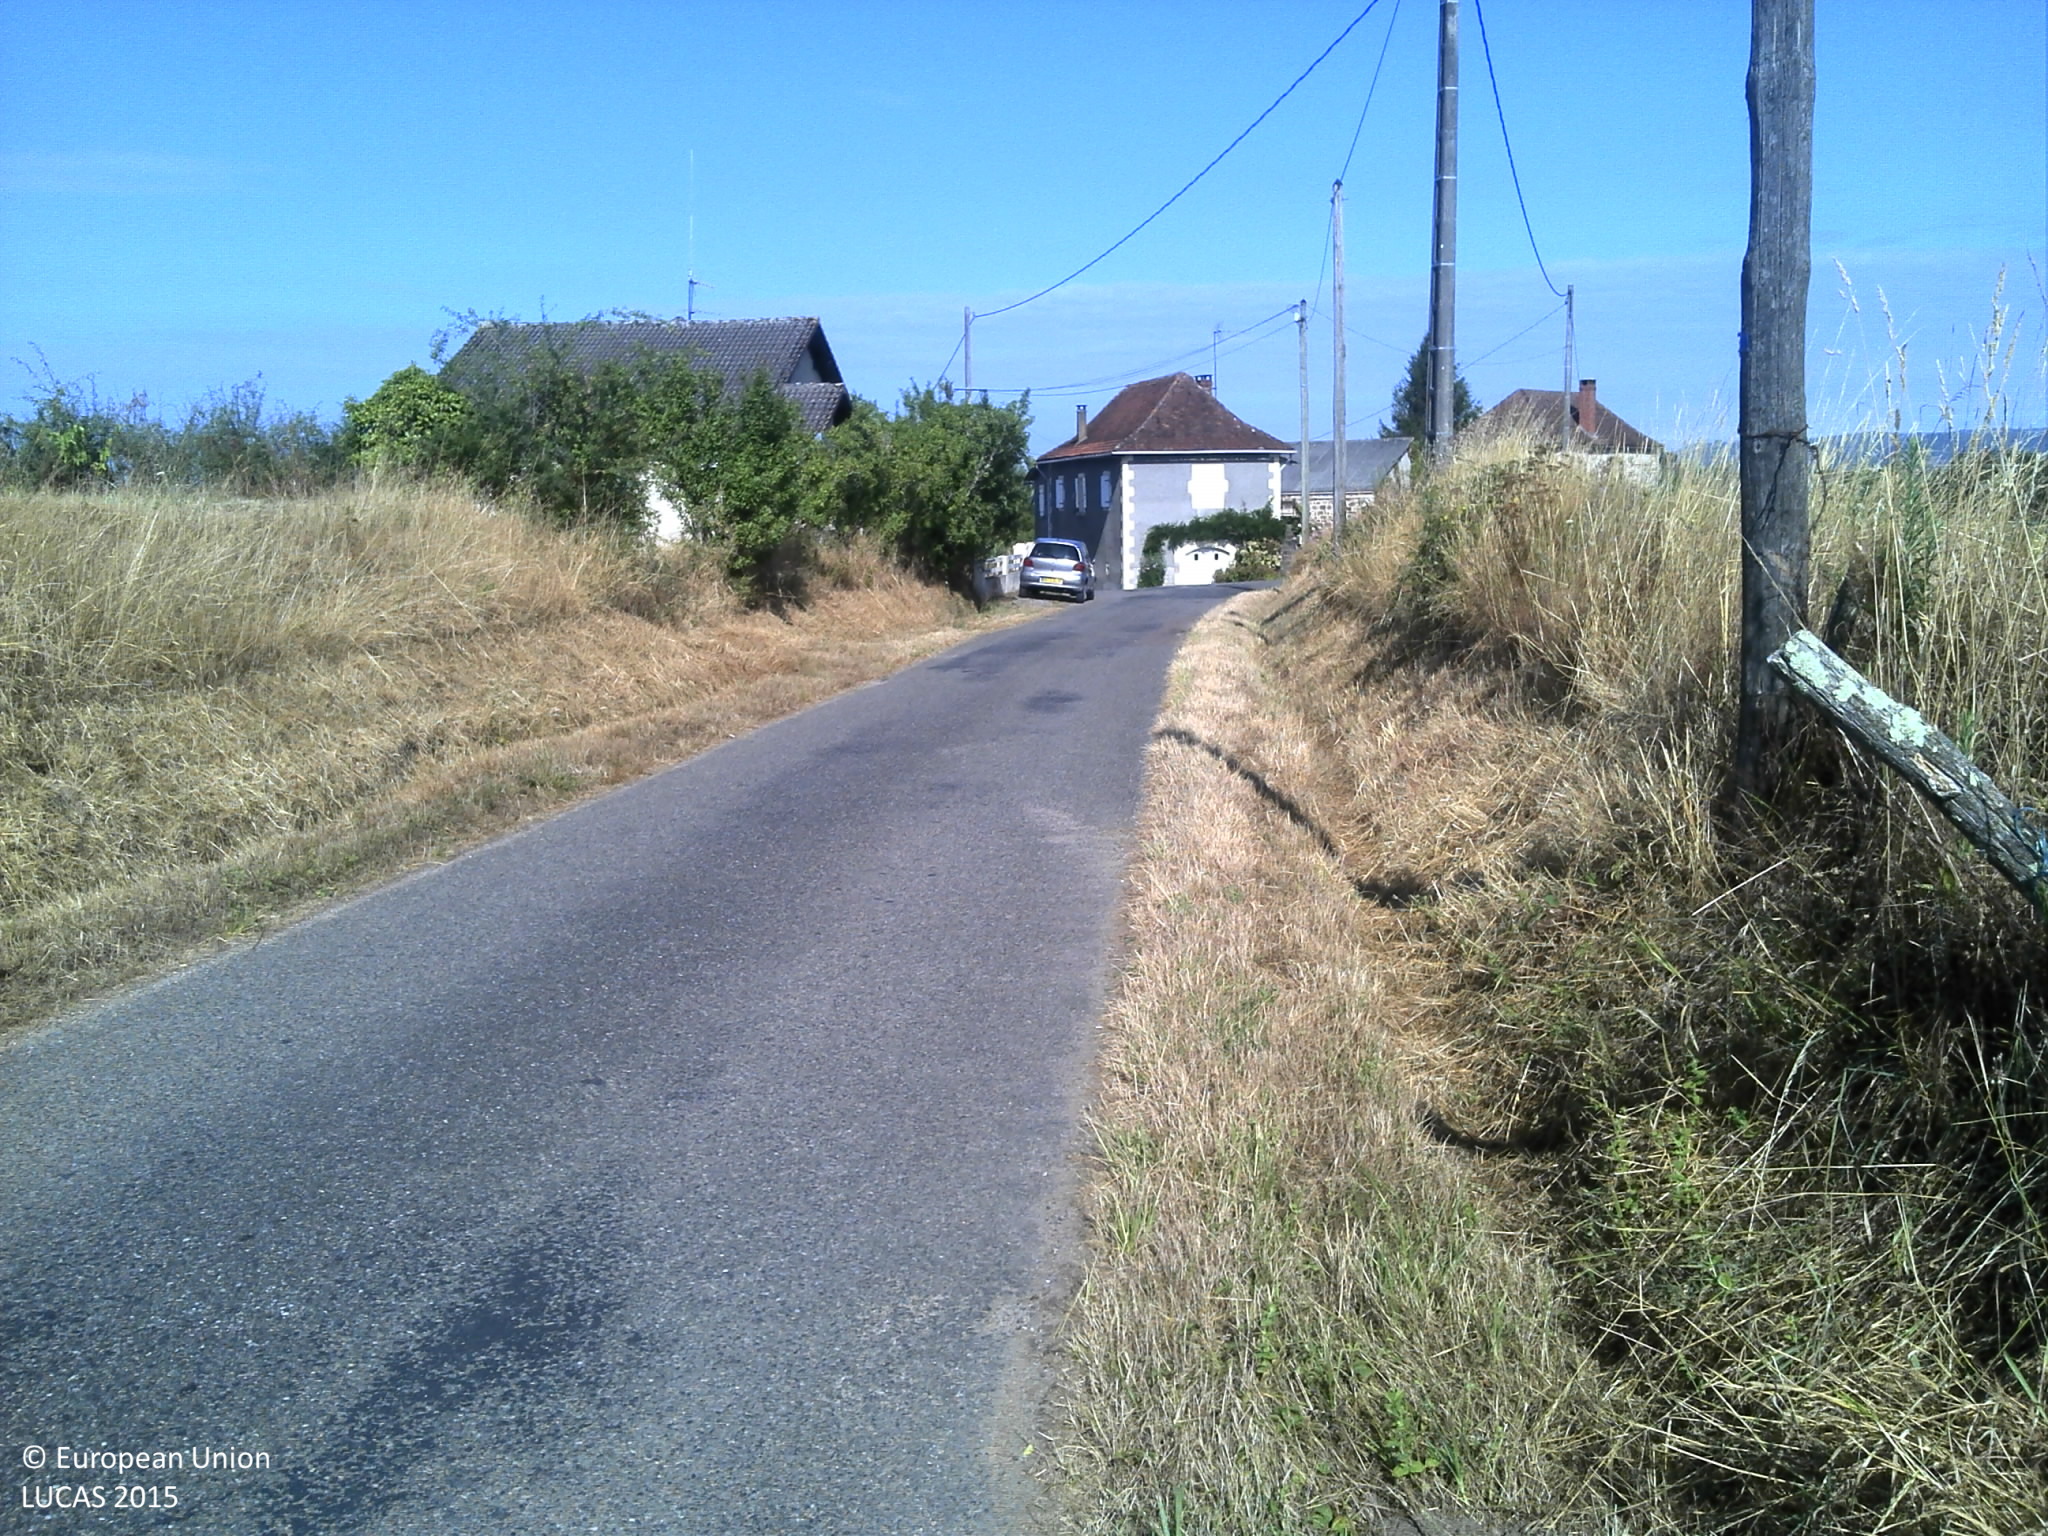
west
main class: Cropland
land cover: Mixed cereals for fodder
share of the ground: > 75 %
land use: Agriculture (excluding fallow land and kitchen gardens)
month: July
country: FR
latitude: 45.0190
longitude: 1.7613
